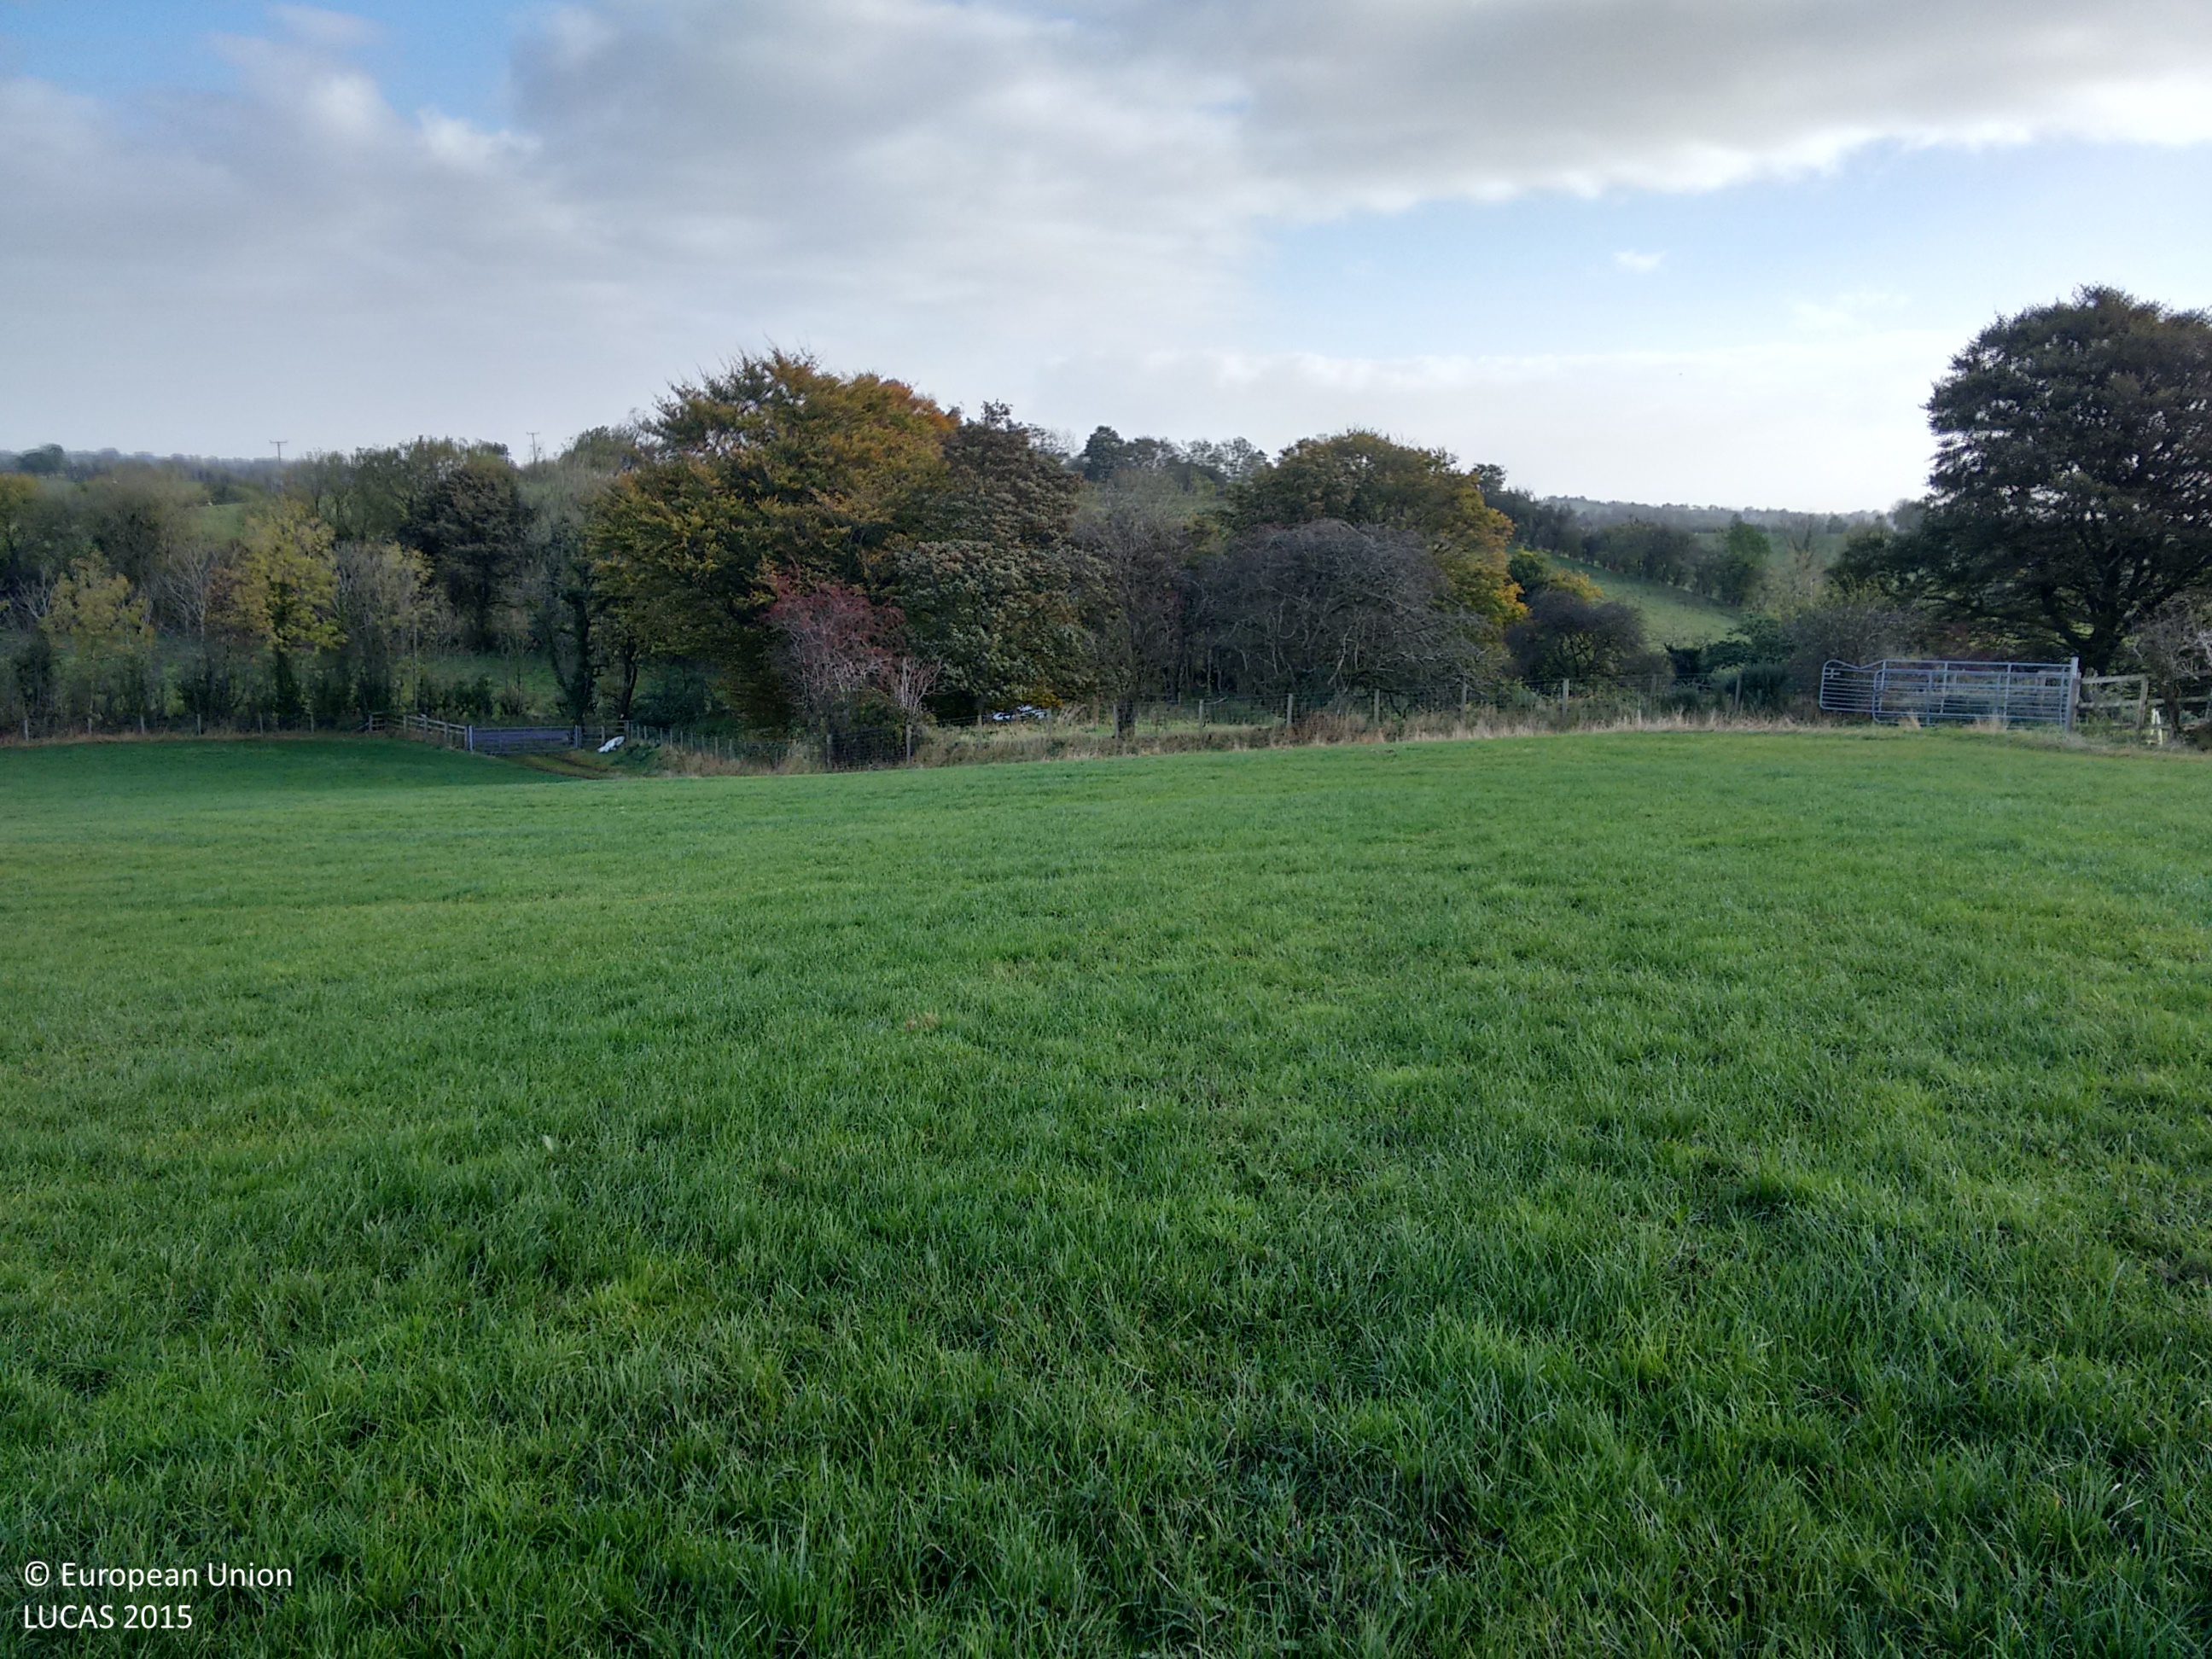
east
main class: Grassland
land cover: Grassland without tree/shrub cover
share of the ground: > 75 %
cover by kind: herbaceous plants 100 %
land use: Agriculture (excluding fallow land and kitchen gardens)
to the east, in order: Grassland without tree/shrub cover; Tracks; Fences; Grassland without tree/shrub cover; Other bare soil; Grassland with sparse tree/shrub cover; Tracks; Grass margins; Ditches and canals; Abandoned hedges; Fences; Grassland without tree/shrub cover; Fences; Managed hedges; Grass margins; Paved roads, cycling and walking lanes; Grass margins; Managed hedges; Fences; Electric lines; Grassland without tree/shrub cover; Fences; Abandoned hedges; Grassland without tree/shrub cover
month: October
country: GB
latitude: 54.4830
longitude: -7.4251
